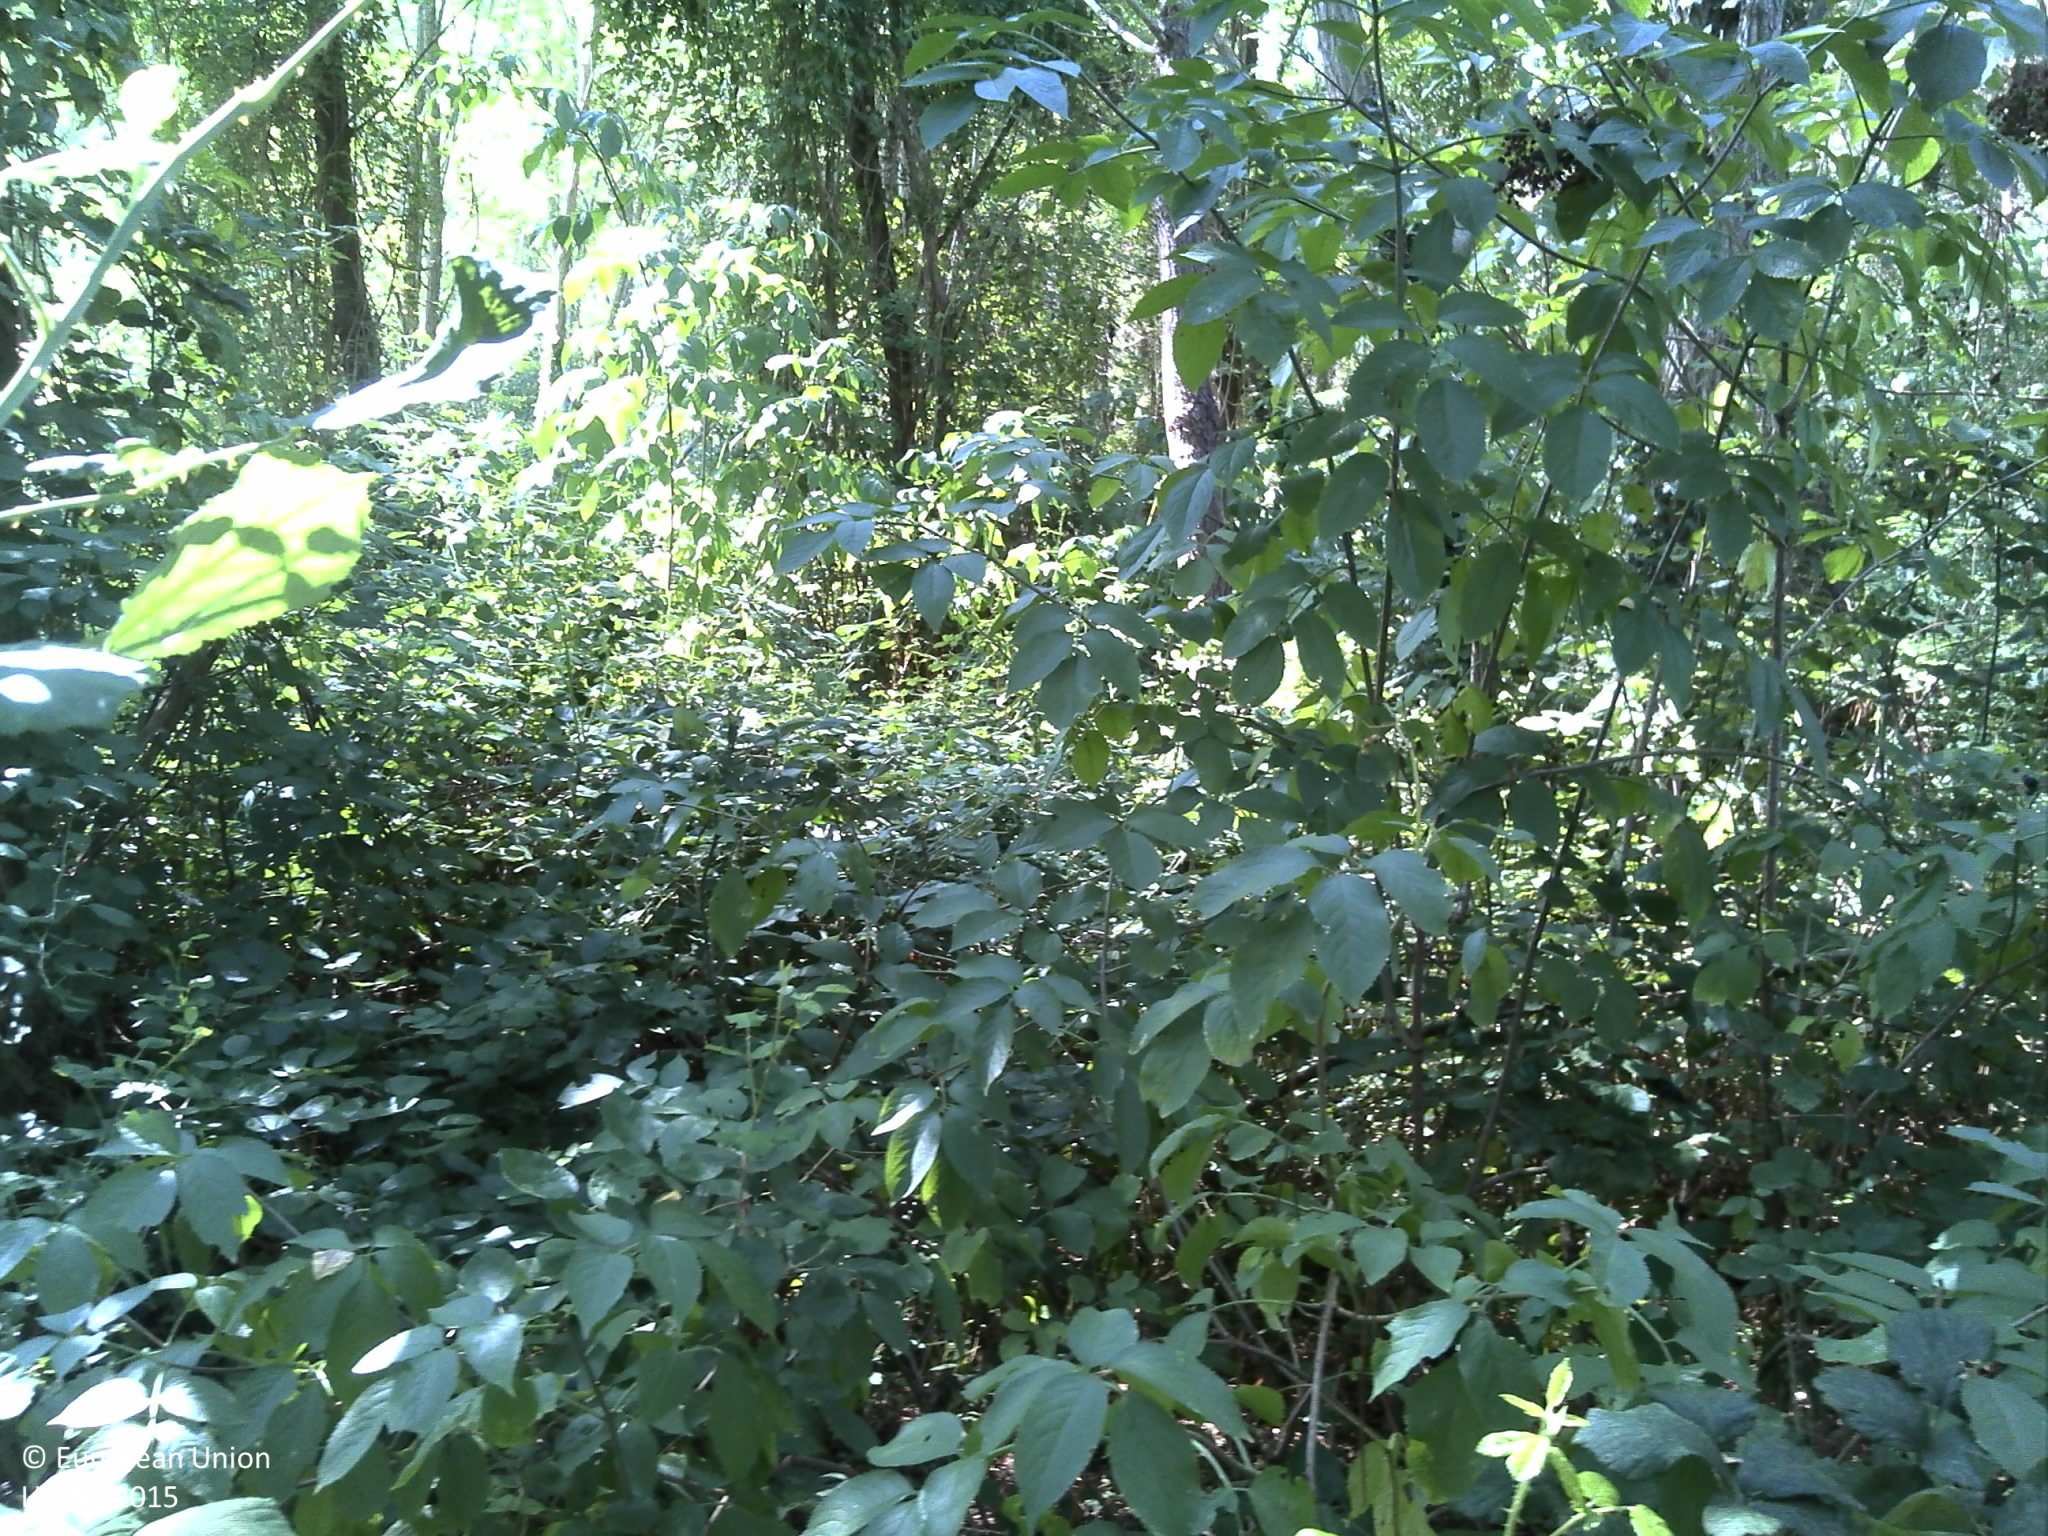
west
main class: Woodland
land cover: Broadleaved woodland
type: floodplain forest
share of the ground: > 75 %
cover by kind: broadleaved forest trees 70 %, shrubs 20 %, herbaceous plants 5 %, lichens and mosses 5 %
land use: Forestry
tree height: > 5 m
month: July
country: FR
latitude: 44.4132
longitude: -0.3494
